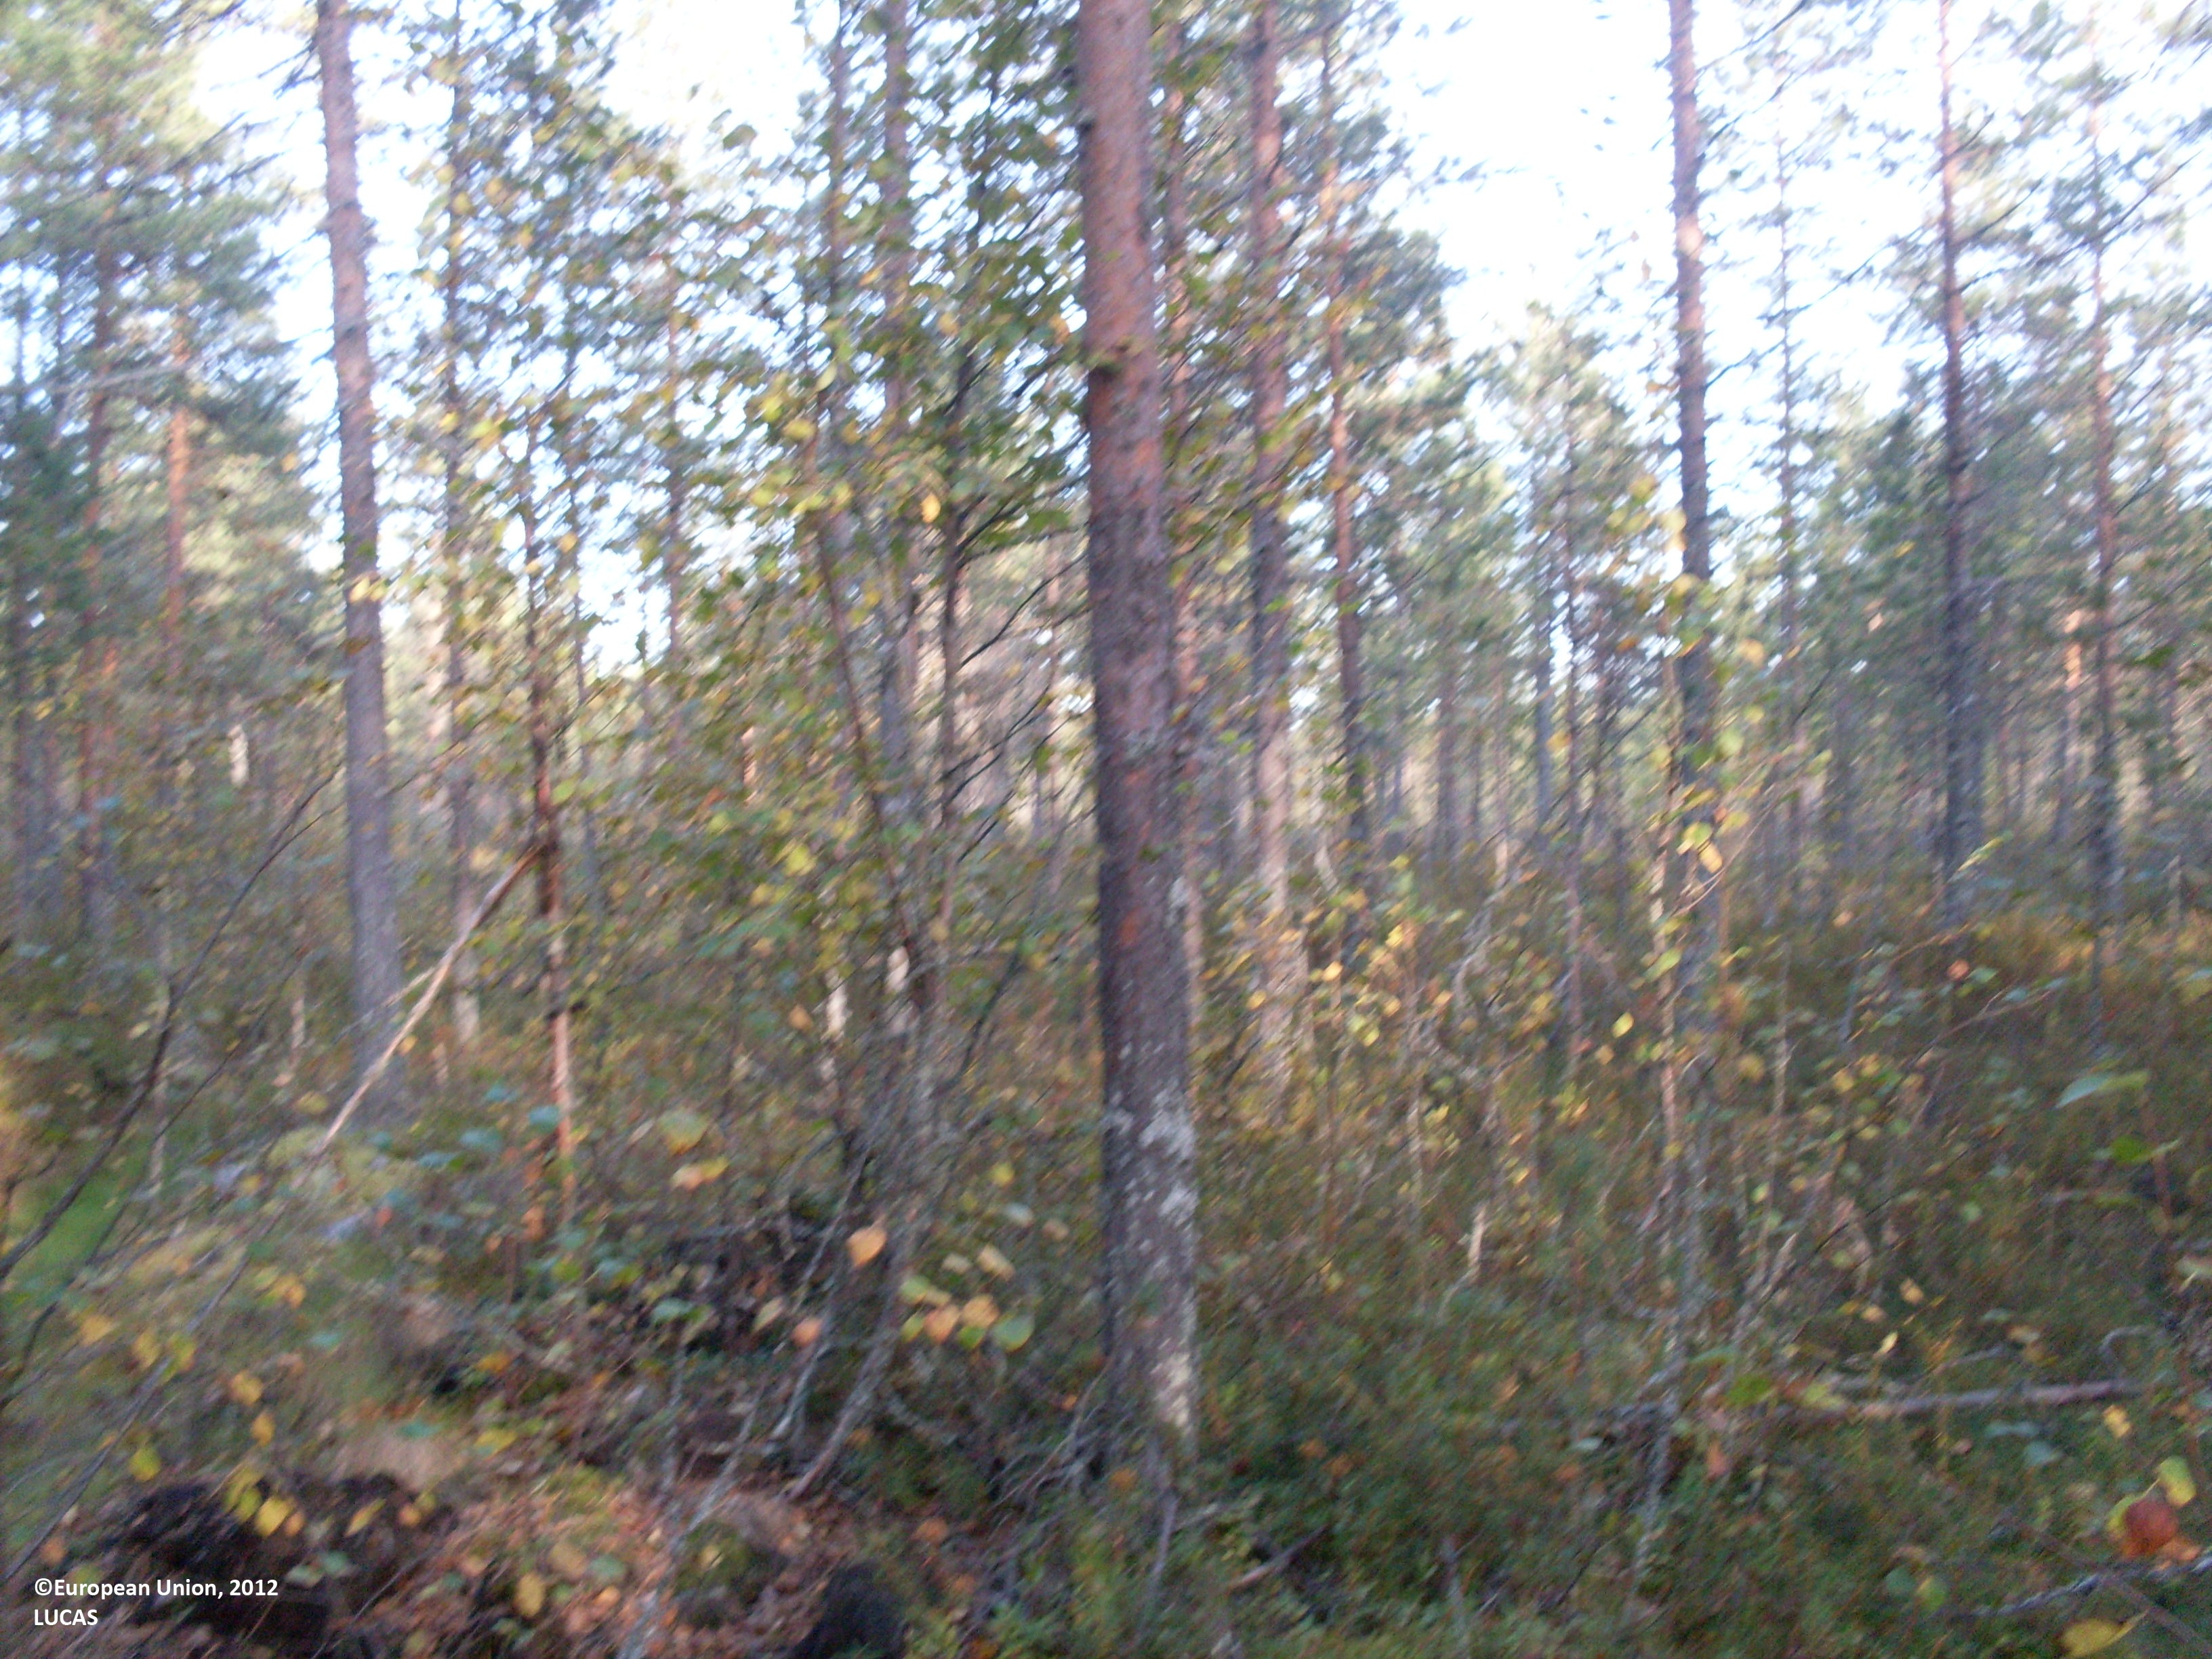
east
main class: Woodland
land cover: Pine dominated coniferous woodland
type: boreal forest
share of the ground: 50 - 75 %
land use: Forestry
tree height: > 5 m
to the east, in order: Pine dominated coniferous woodland; Pine dominated mixed woodland; Ditches and canals; Pine dominated mixed woodland; Ditches and canals; Pine dominated mixed woodland; Ditches and canals; Pine dominated mixed woodland
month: September
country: FI
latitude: 64.0790
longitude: 29.2578
